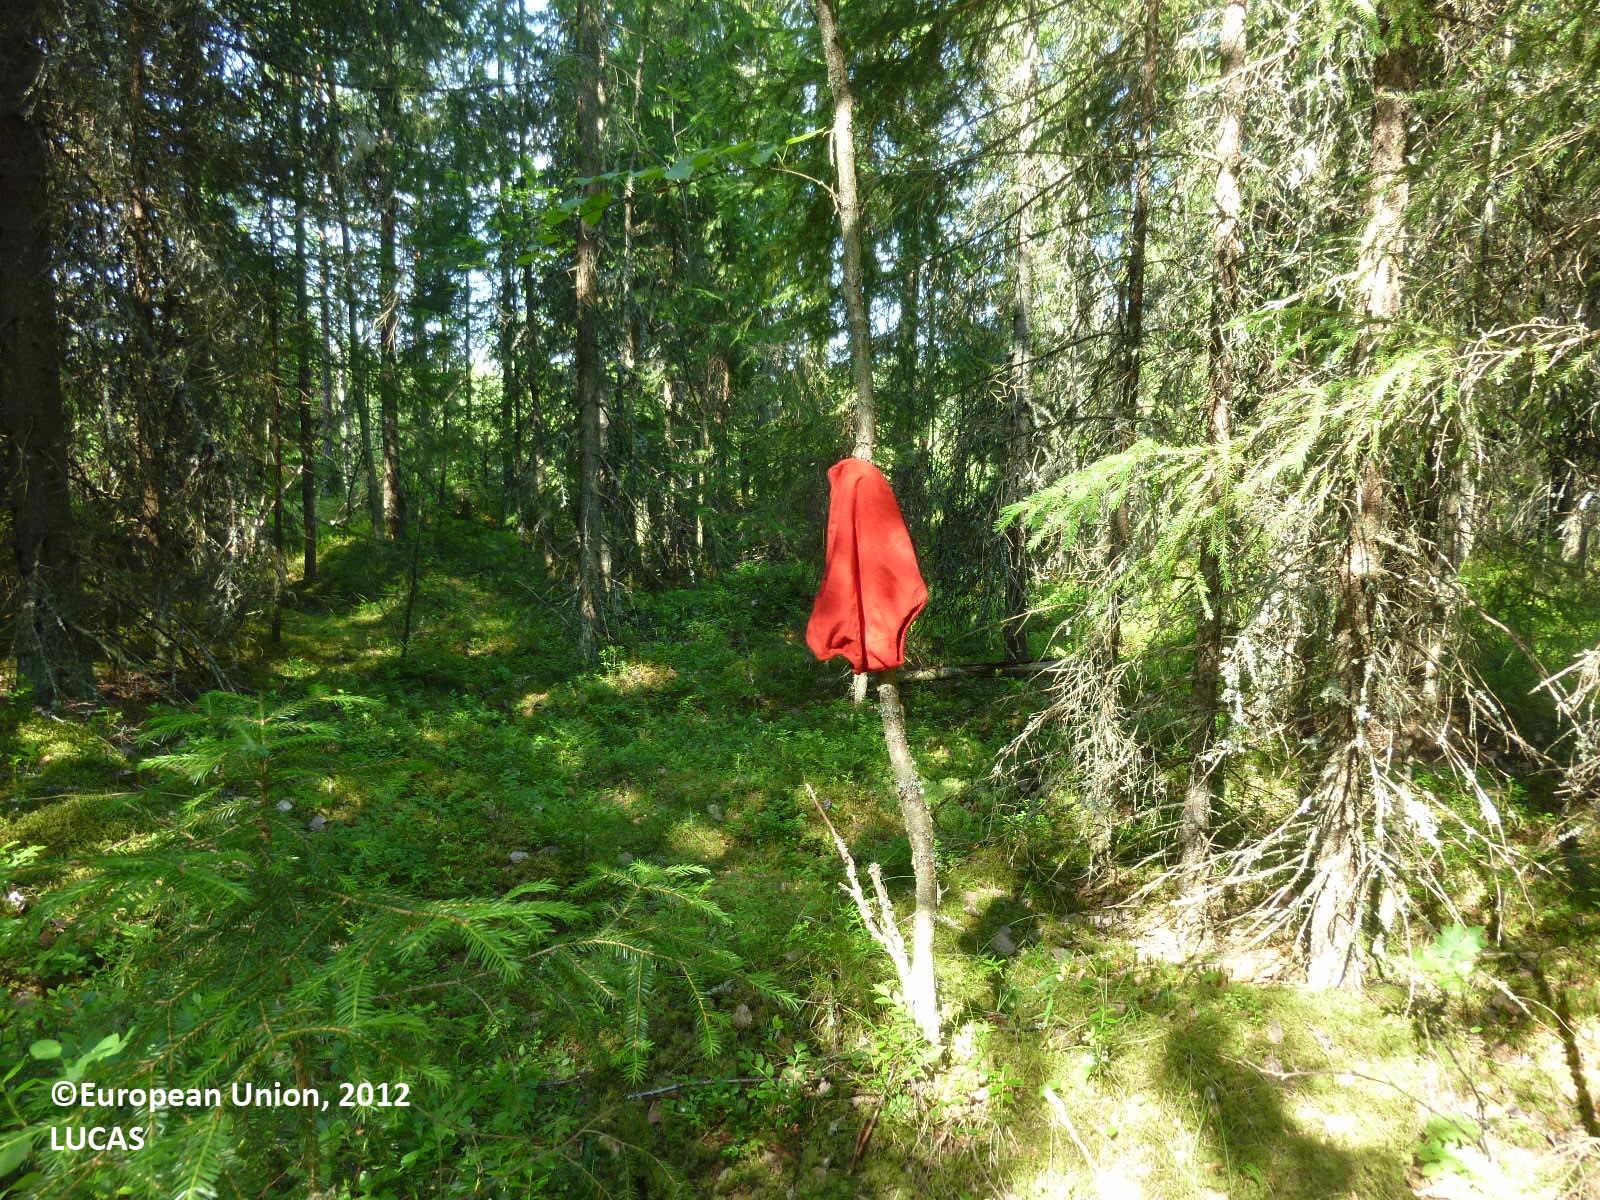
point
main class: Woodland
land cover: Spruce dominated coniferous woodland
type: boreal forest
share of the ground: > 75 %
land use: Forestry
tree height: > 5 m
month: July
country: FI
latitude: 61.1326
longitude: 22.5634
